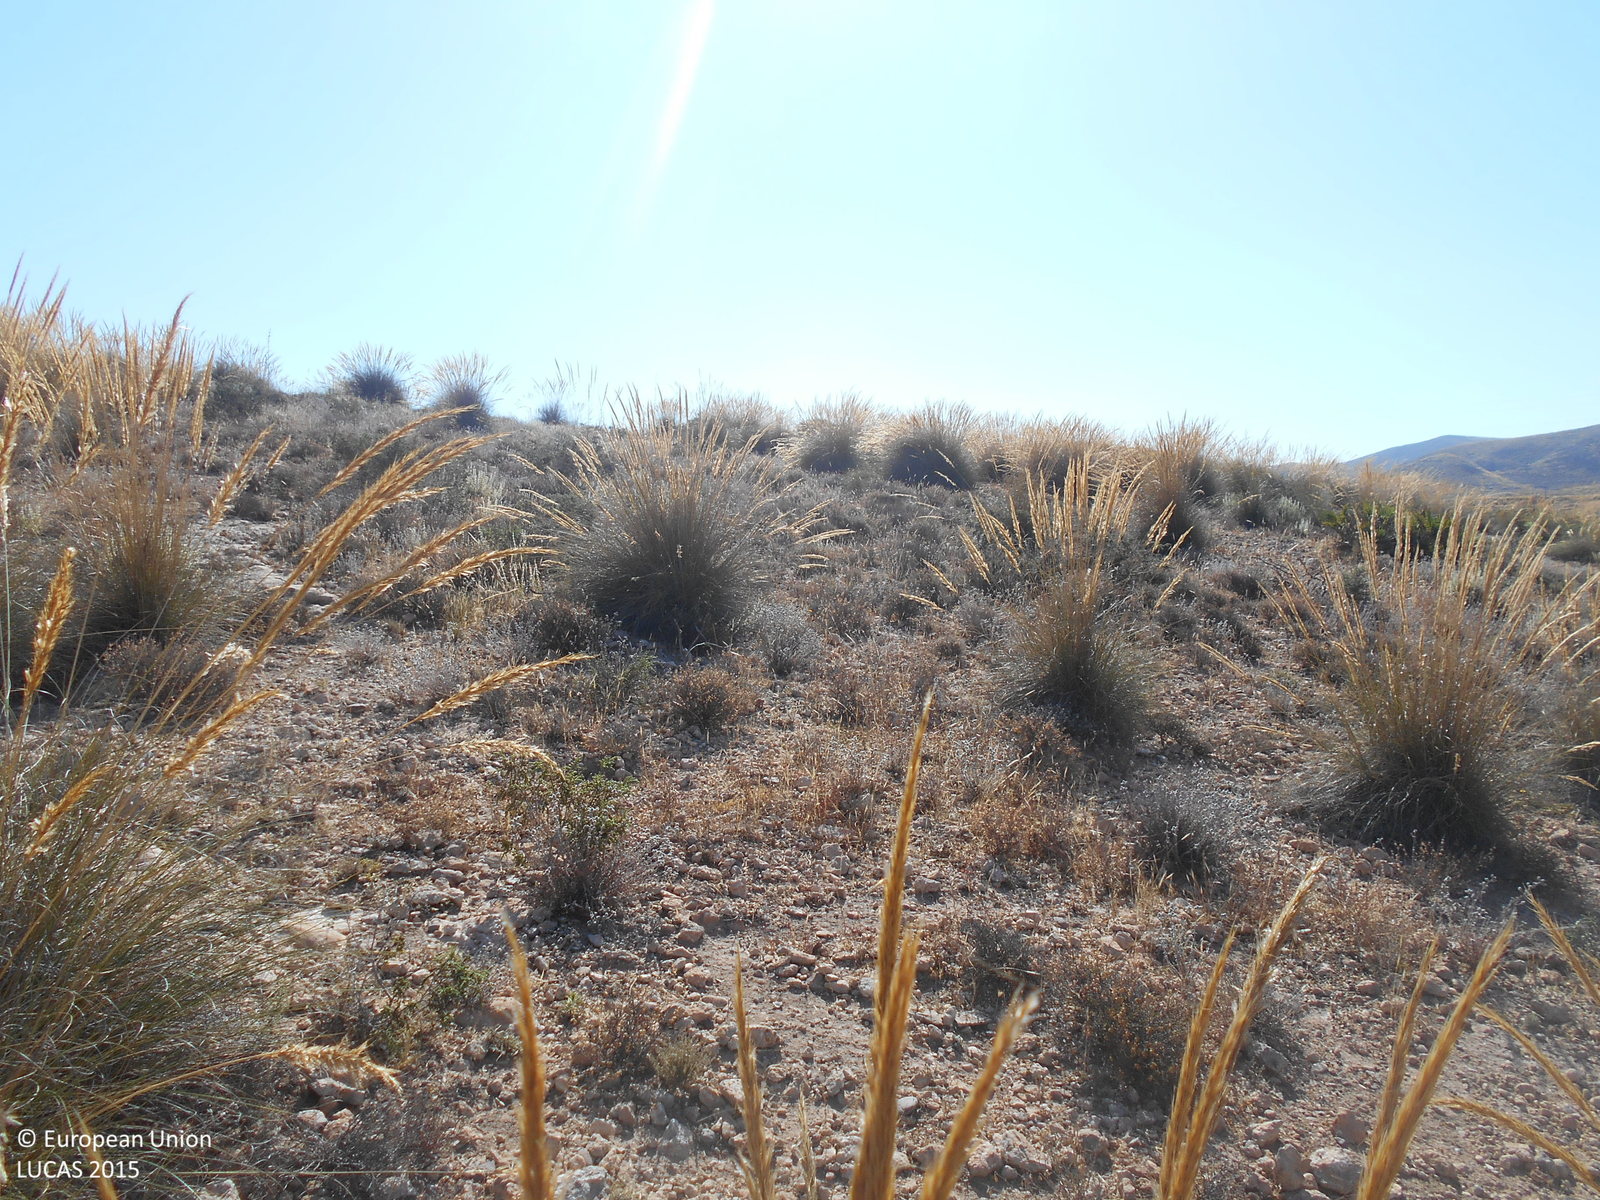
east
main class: Shrubland
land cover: Shrubland without tree cover
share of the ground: 25 - 50 %
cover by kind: shrubs 30 %, consolidated bare surface 30 %, unconsolidated bare surface 30 %, herbaceous plants 10 %
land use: Semi-natural and natural areas not in use
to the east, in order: Shrubland without tree cover; Other bare soil; Grassland without tree/shrub cover; Tracks; Shruby margins; Grassland without tree/shrub cover; Electric lines; Grassland without tree/shrub cover
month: May
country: ES
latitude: 36.8592
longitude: -2.1208
